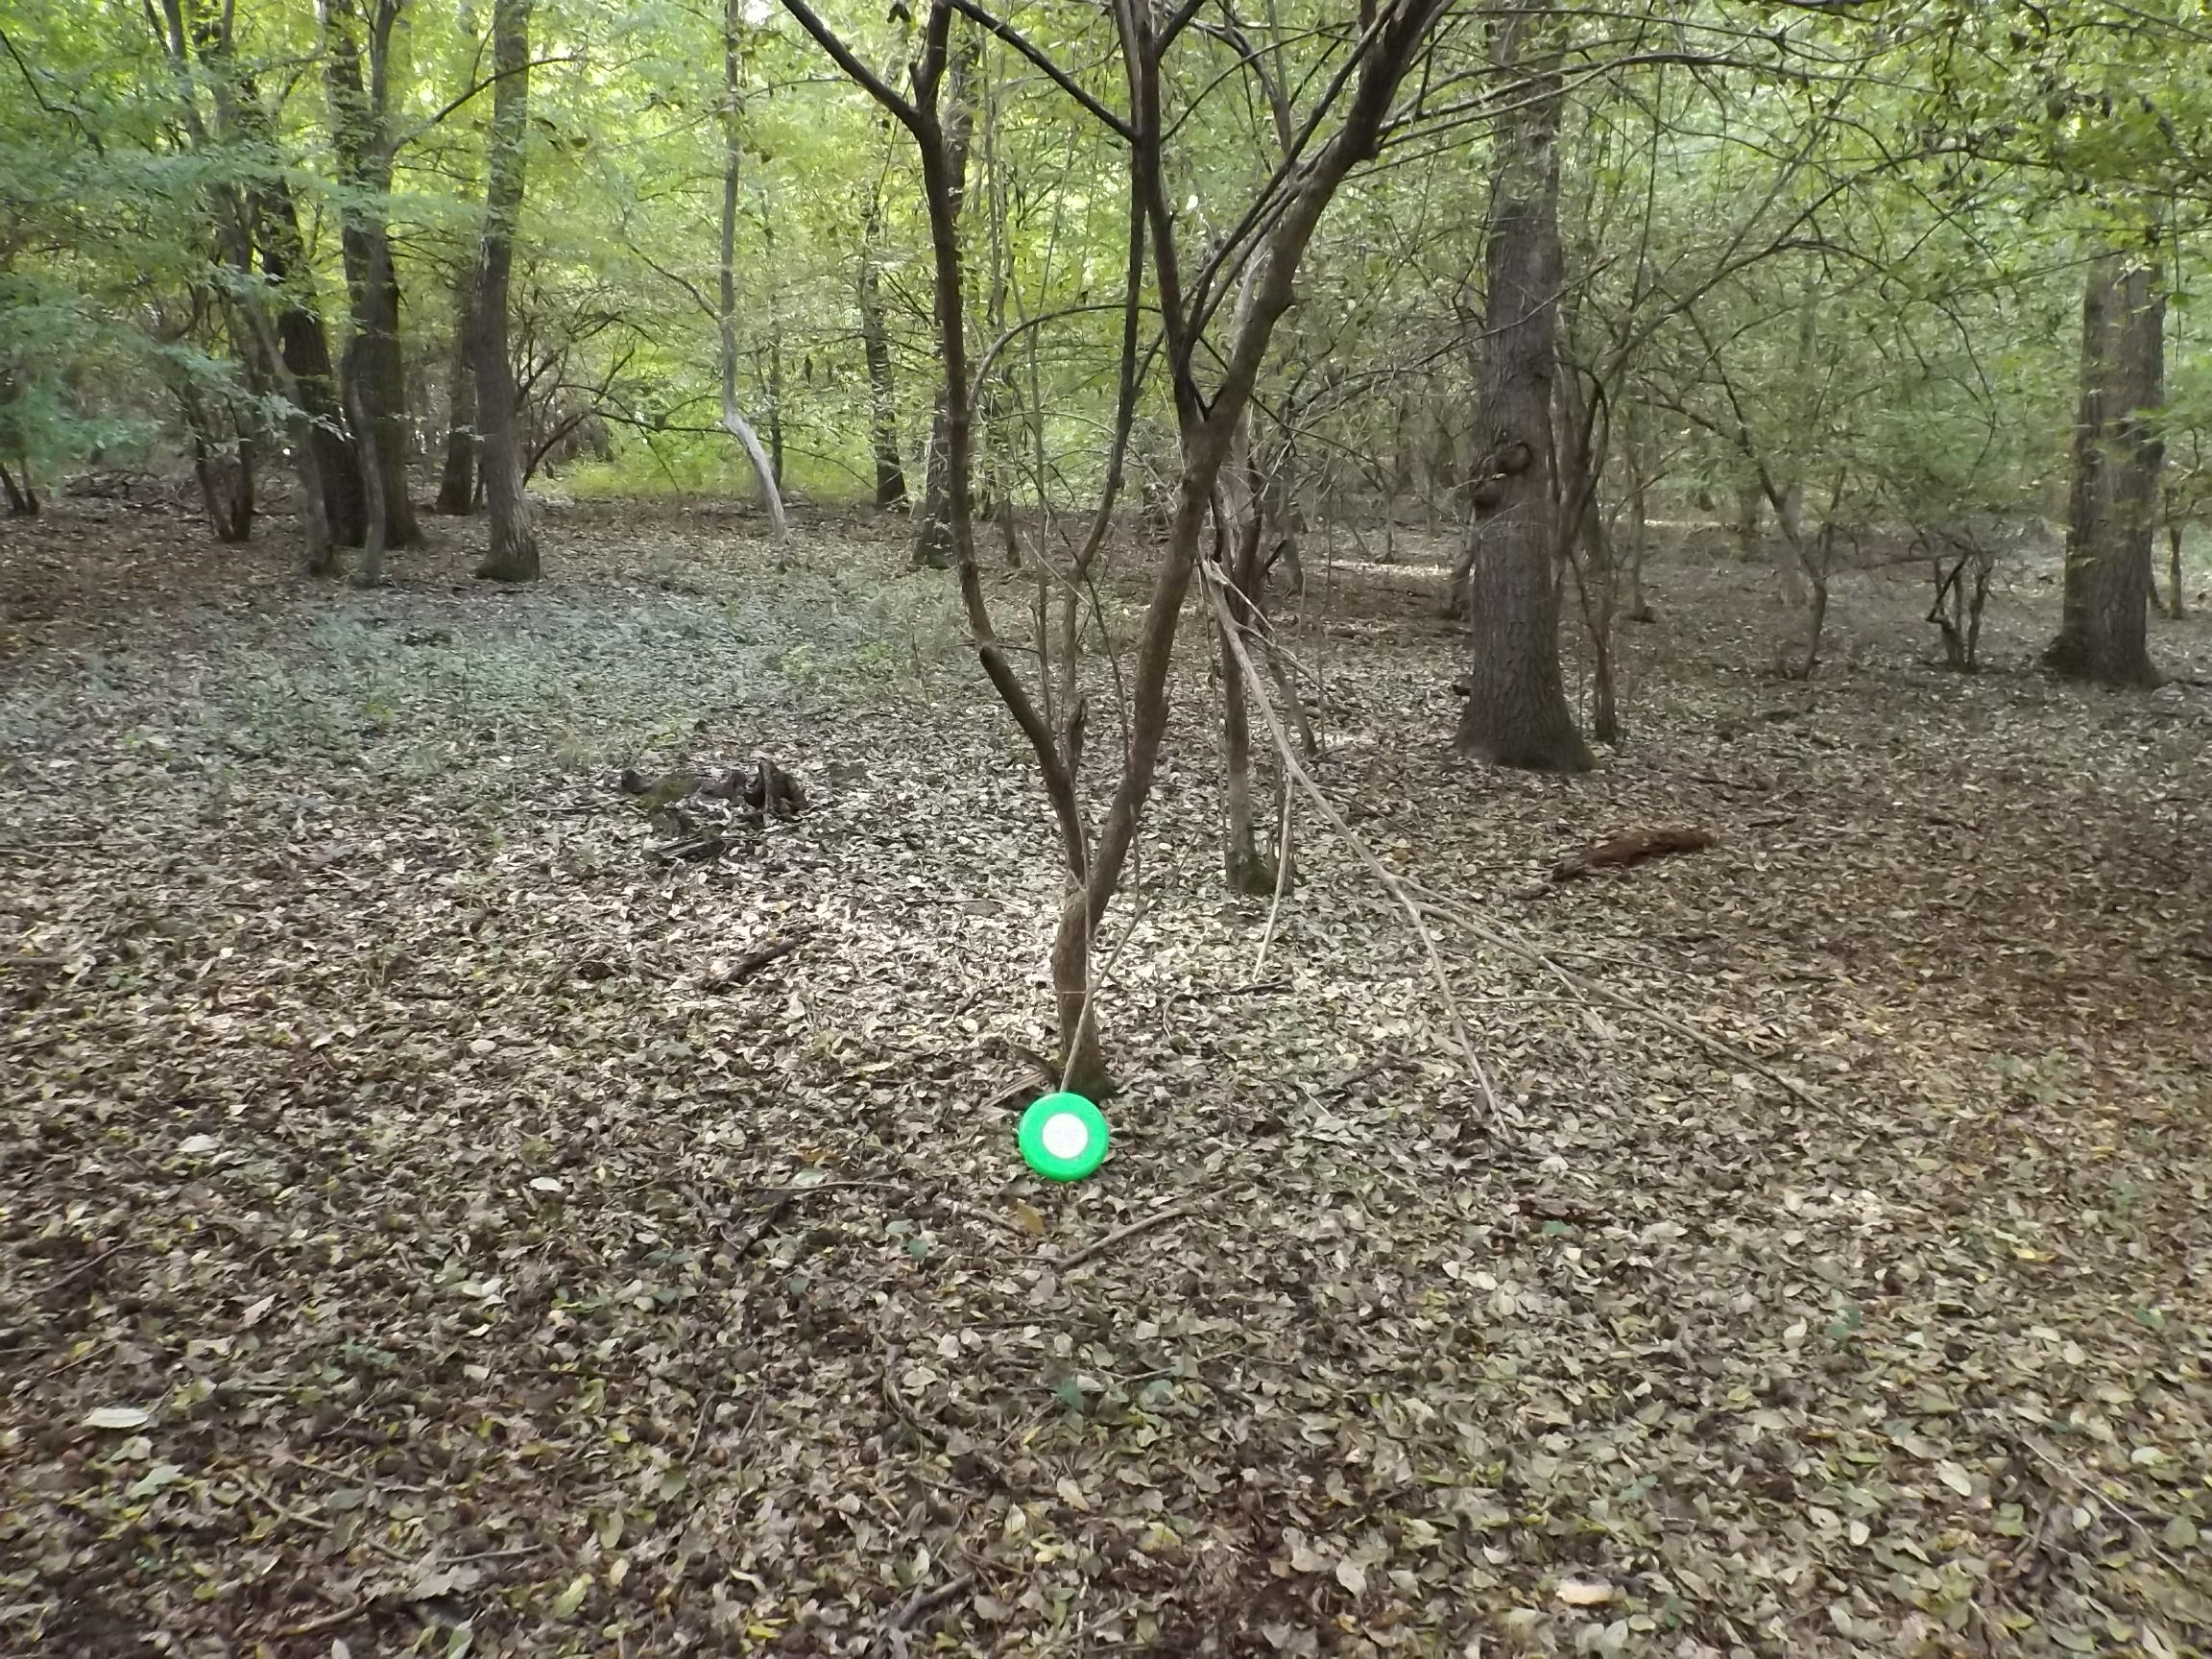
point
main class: Woodland
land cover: Broadleaved woodland
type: beech forest
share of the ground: > 75 %
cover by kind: broadleaved forest trees 100 %
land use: Forestry
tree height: > 5 m
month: October
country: BG
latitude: 43.9032
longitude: 26.7113
